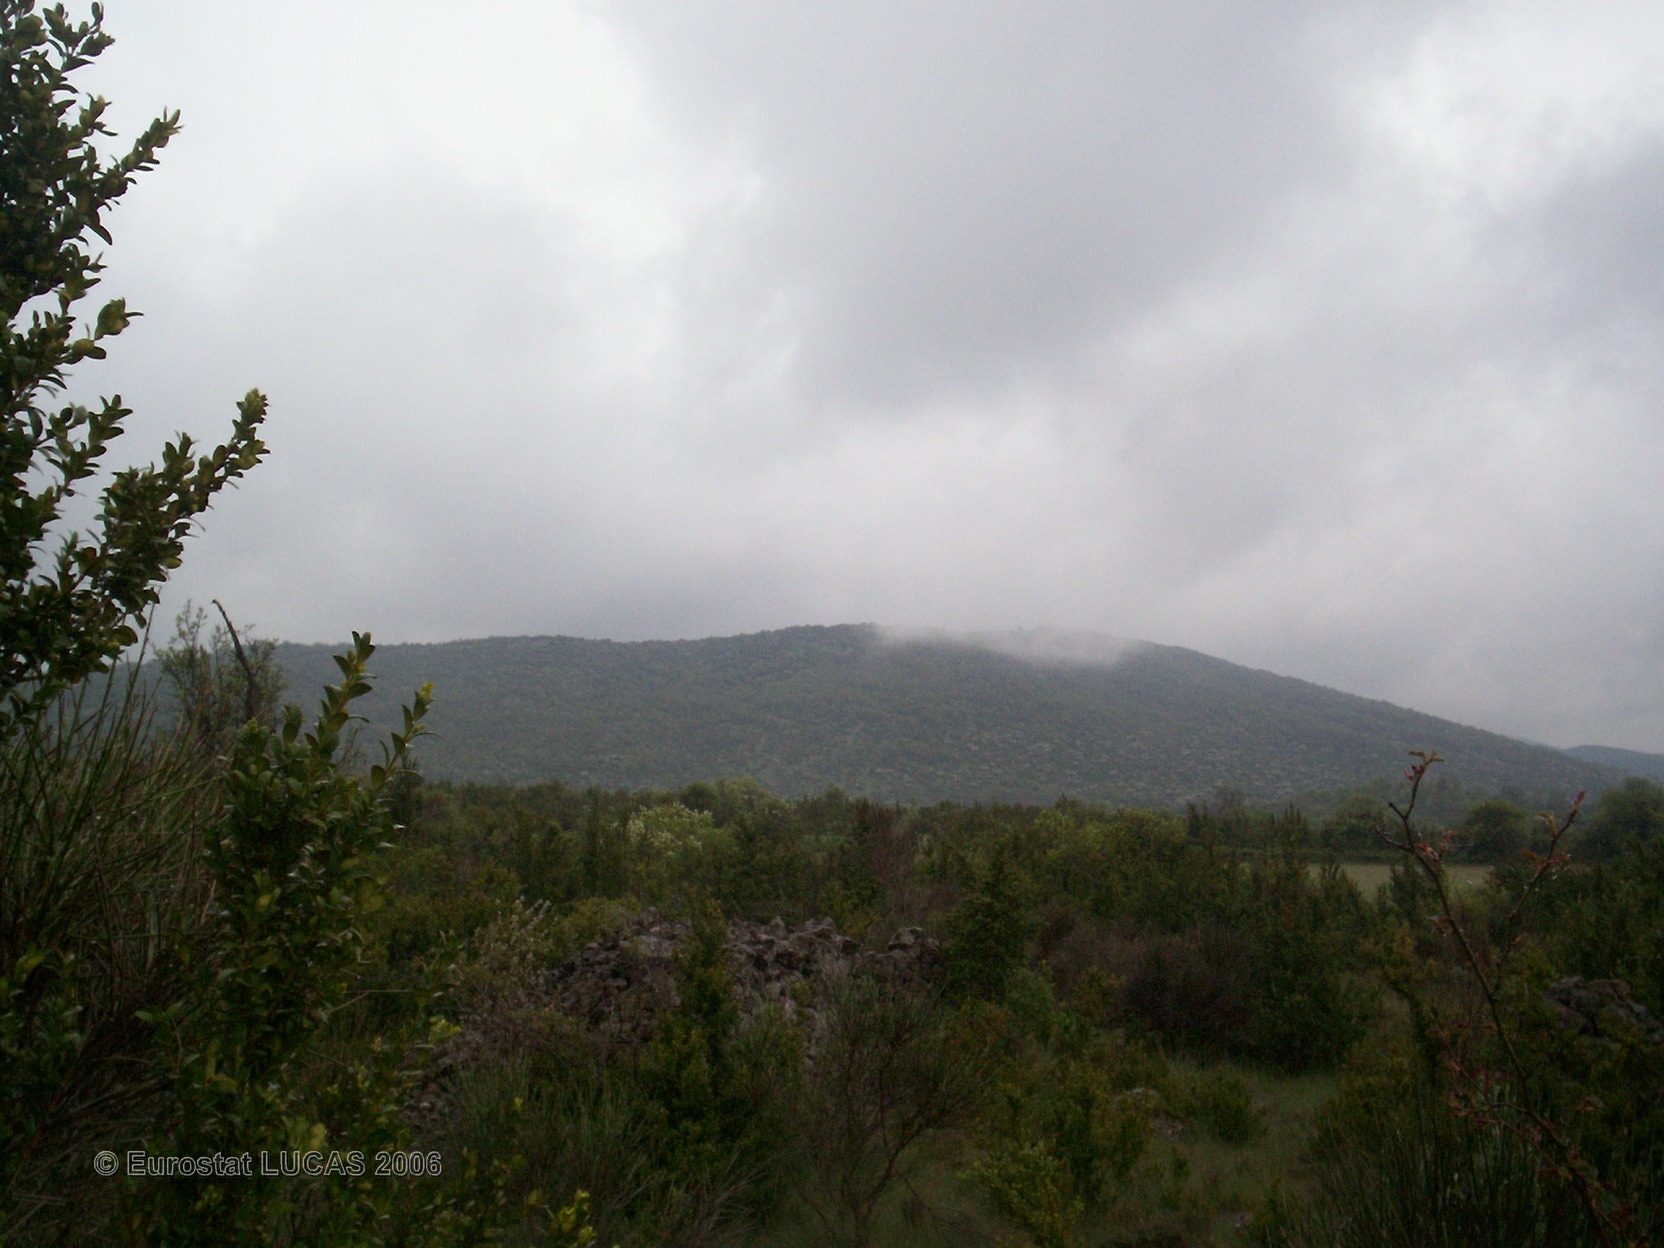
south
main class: Shrubland
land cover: Shrubland without tree cover
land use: Unused
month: May
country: FR
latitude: 43.9291
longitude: 3.4929
